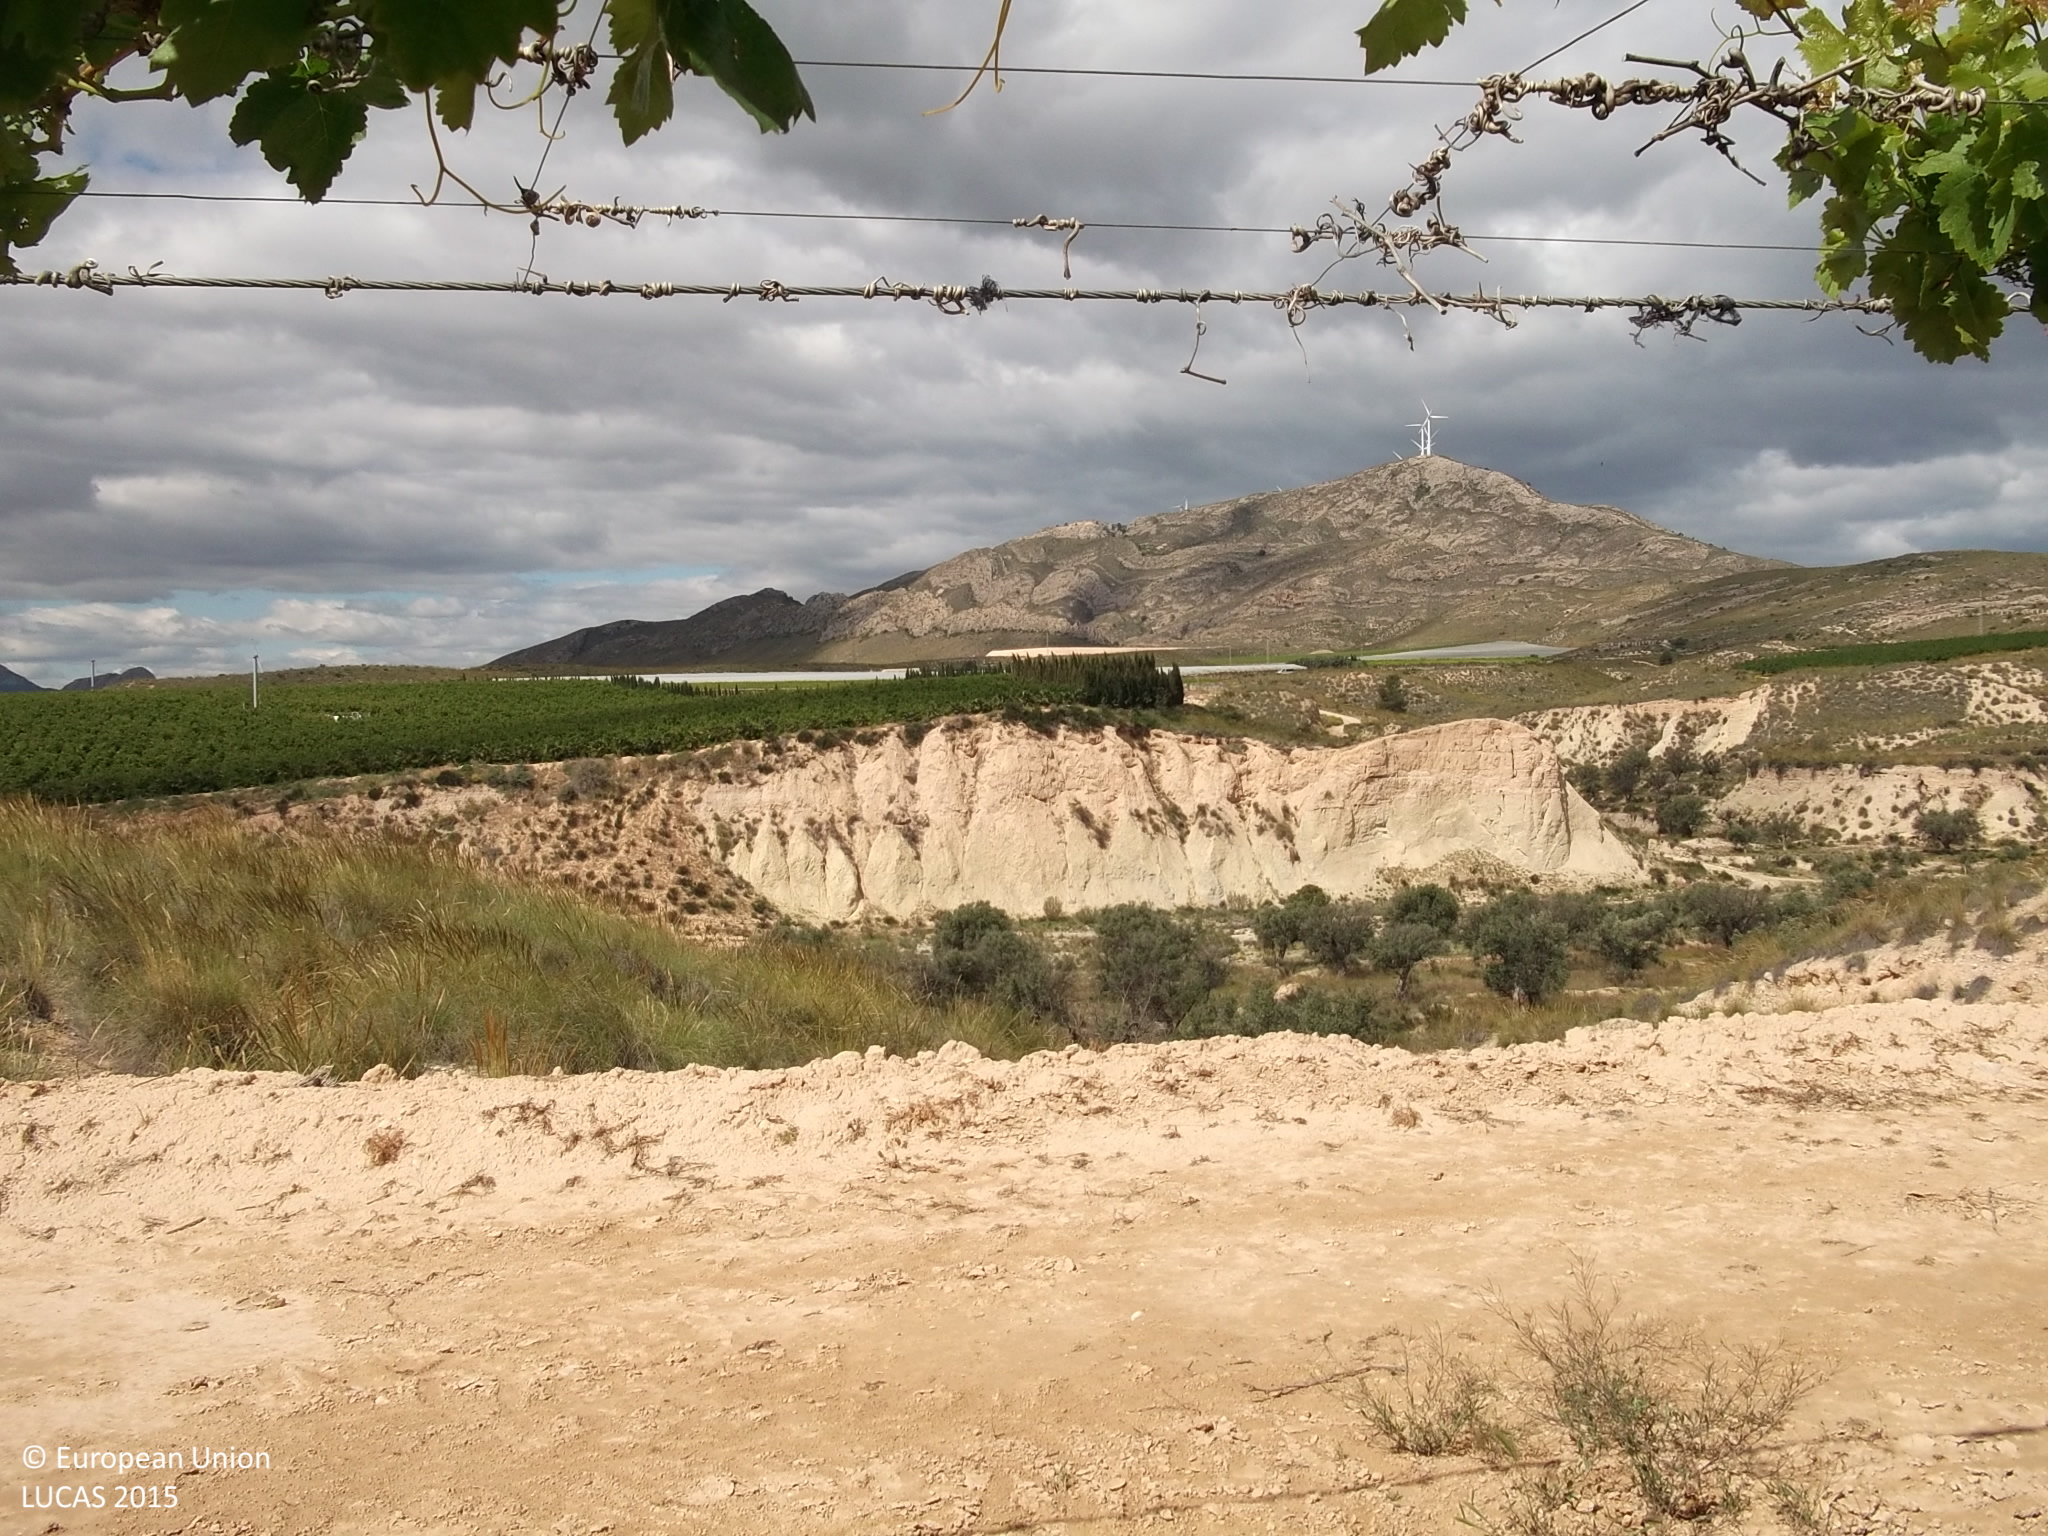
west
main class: Cropland
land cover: Vineyards
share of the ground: > 75 %
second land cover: Other bare soil
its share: > 75 %
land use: Agriculture (excluding fallow land and kitchen gardens)
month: April
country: ES
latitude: 38.2742
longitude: -1.3391
